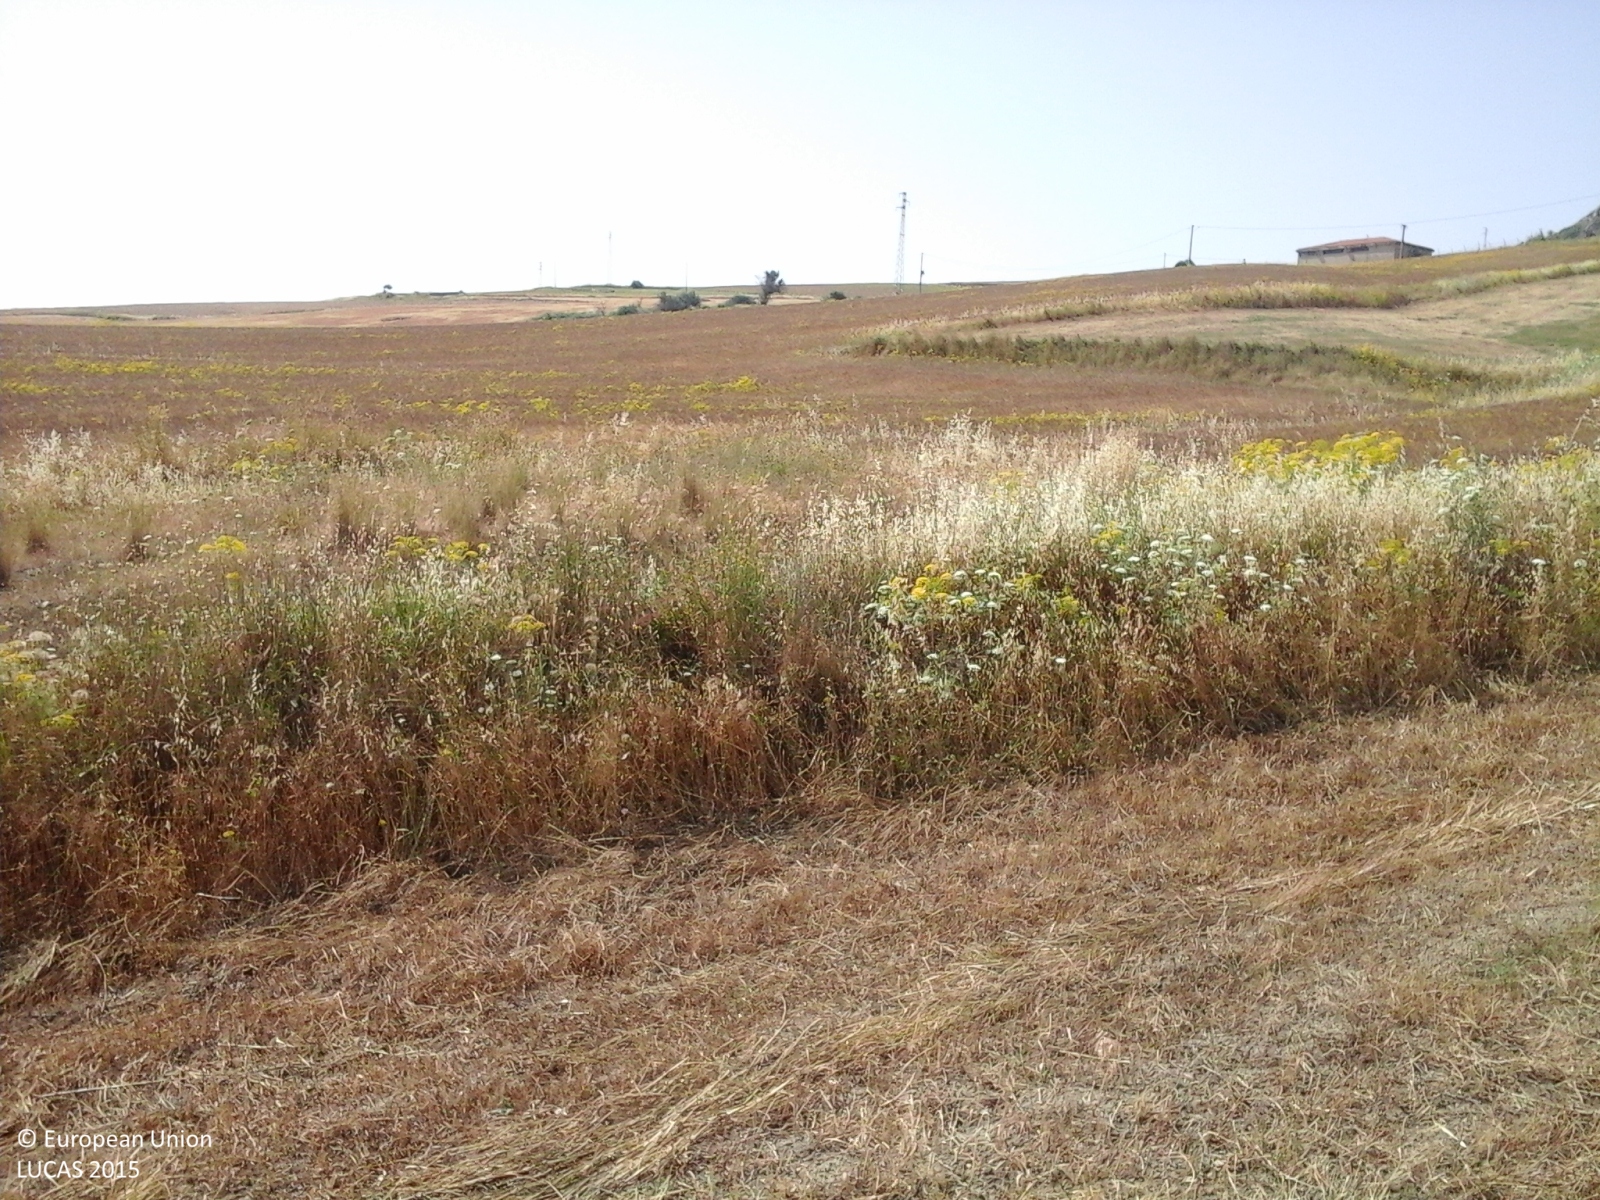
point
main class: Cropland
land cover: Durum wheat
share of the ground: > 75 %
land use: Agriculture (excluding fallow land and kitchen gardens)
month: June
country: IT
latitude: 37.4997
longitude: 14.4128
